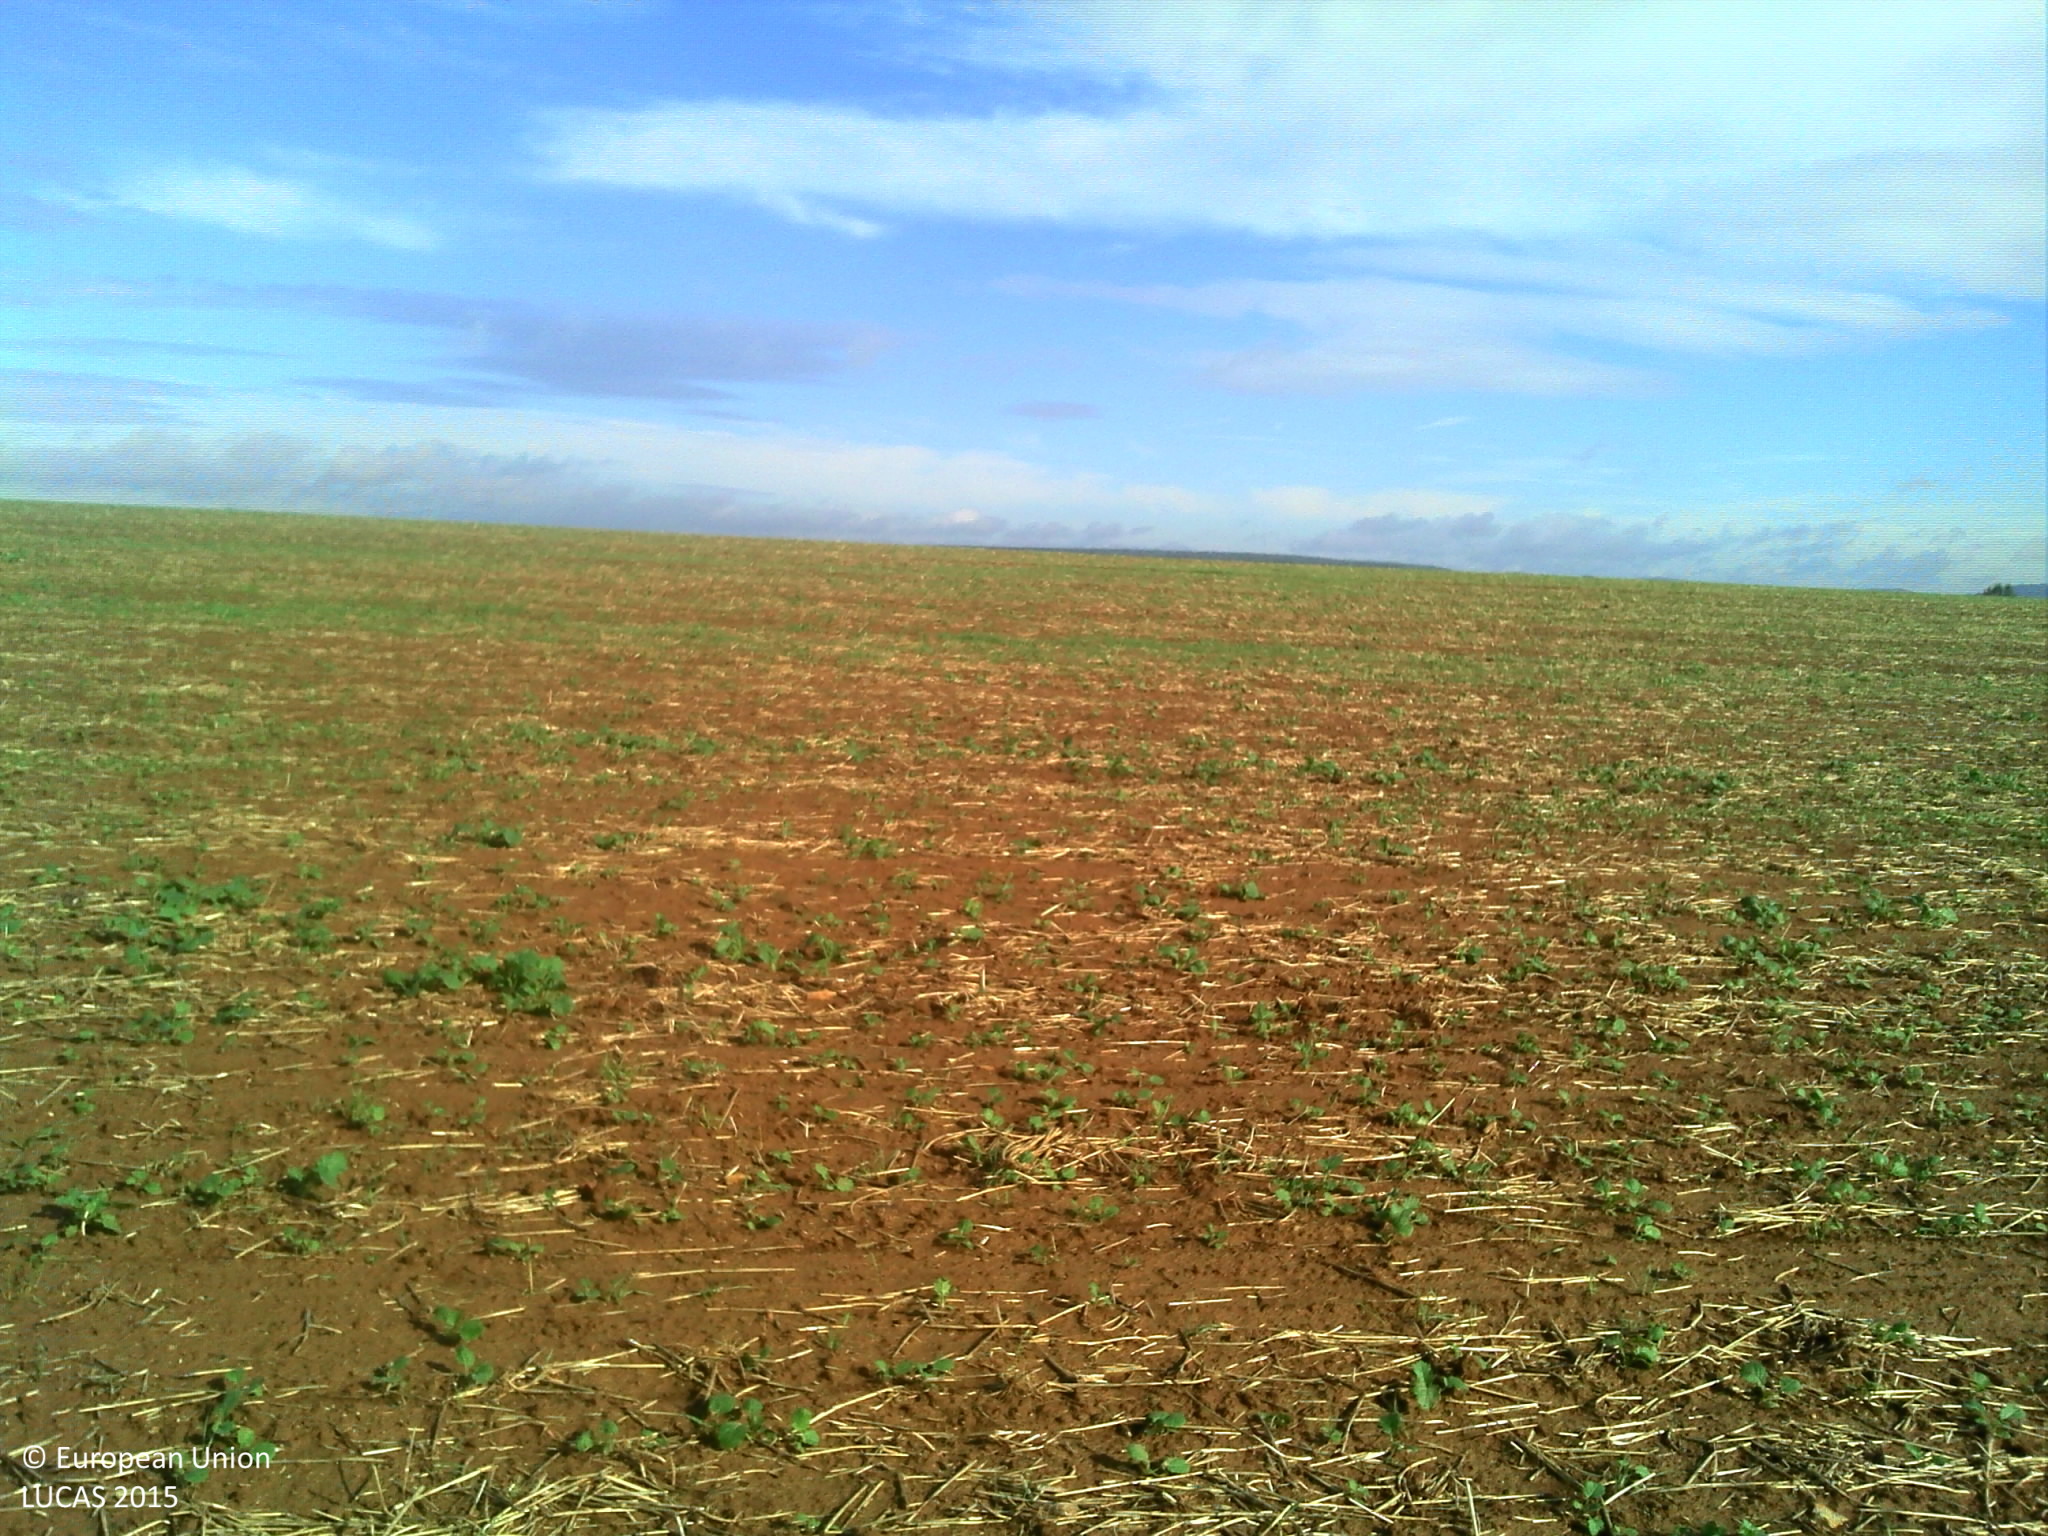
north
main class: Cropland
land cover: Other fibre and oleaginous crops
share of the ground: < 10 %
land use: Agriculture (excluding fallow land and kitchen gardens)
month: September
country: FR
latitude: 48.8179
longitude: 6.0093
